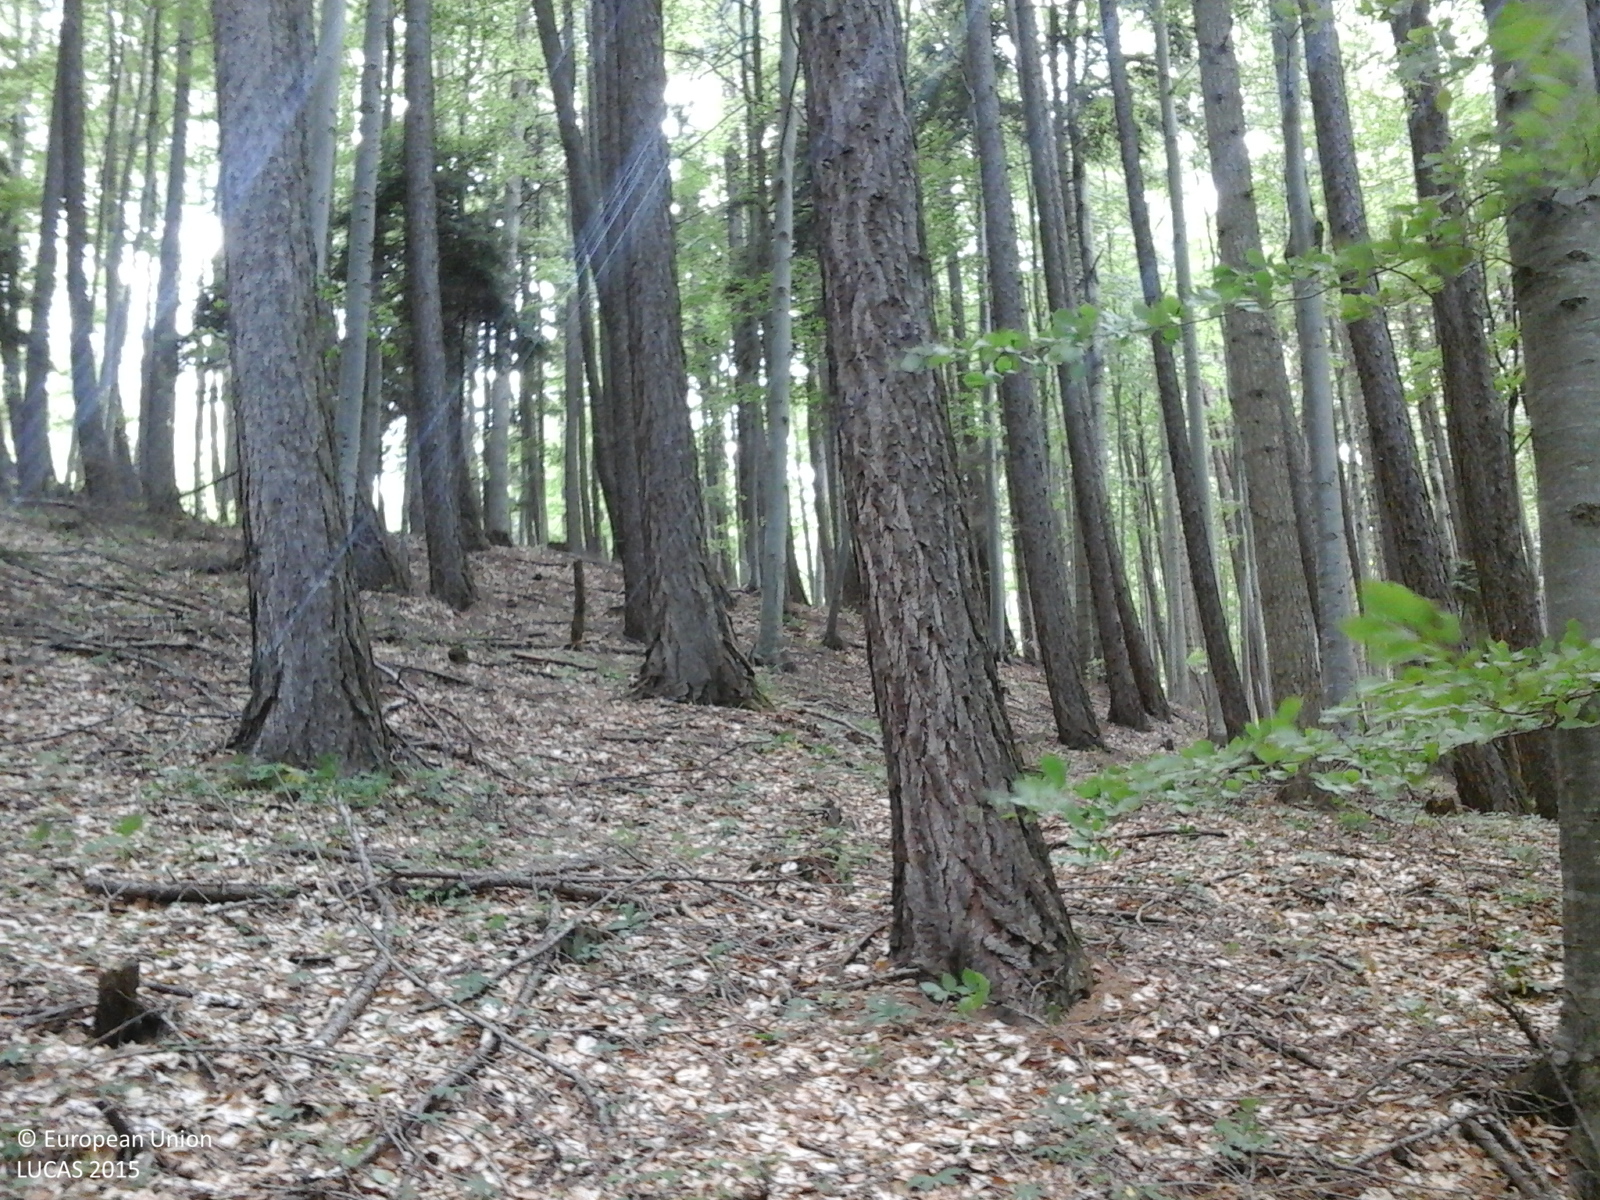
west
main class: Woodland
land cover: Other mixed woodland
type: alpine coniferous forest
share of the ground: > 75 %
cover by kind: coniferous forest trees 70 %, broadleaved forest trees 30 %
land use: Forestry
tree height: > 5 m
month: May
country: RO
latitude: 45.2553
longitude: 25.5829
